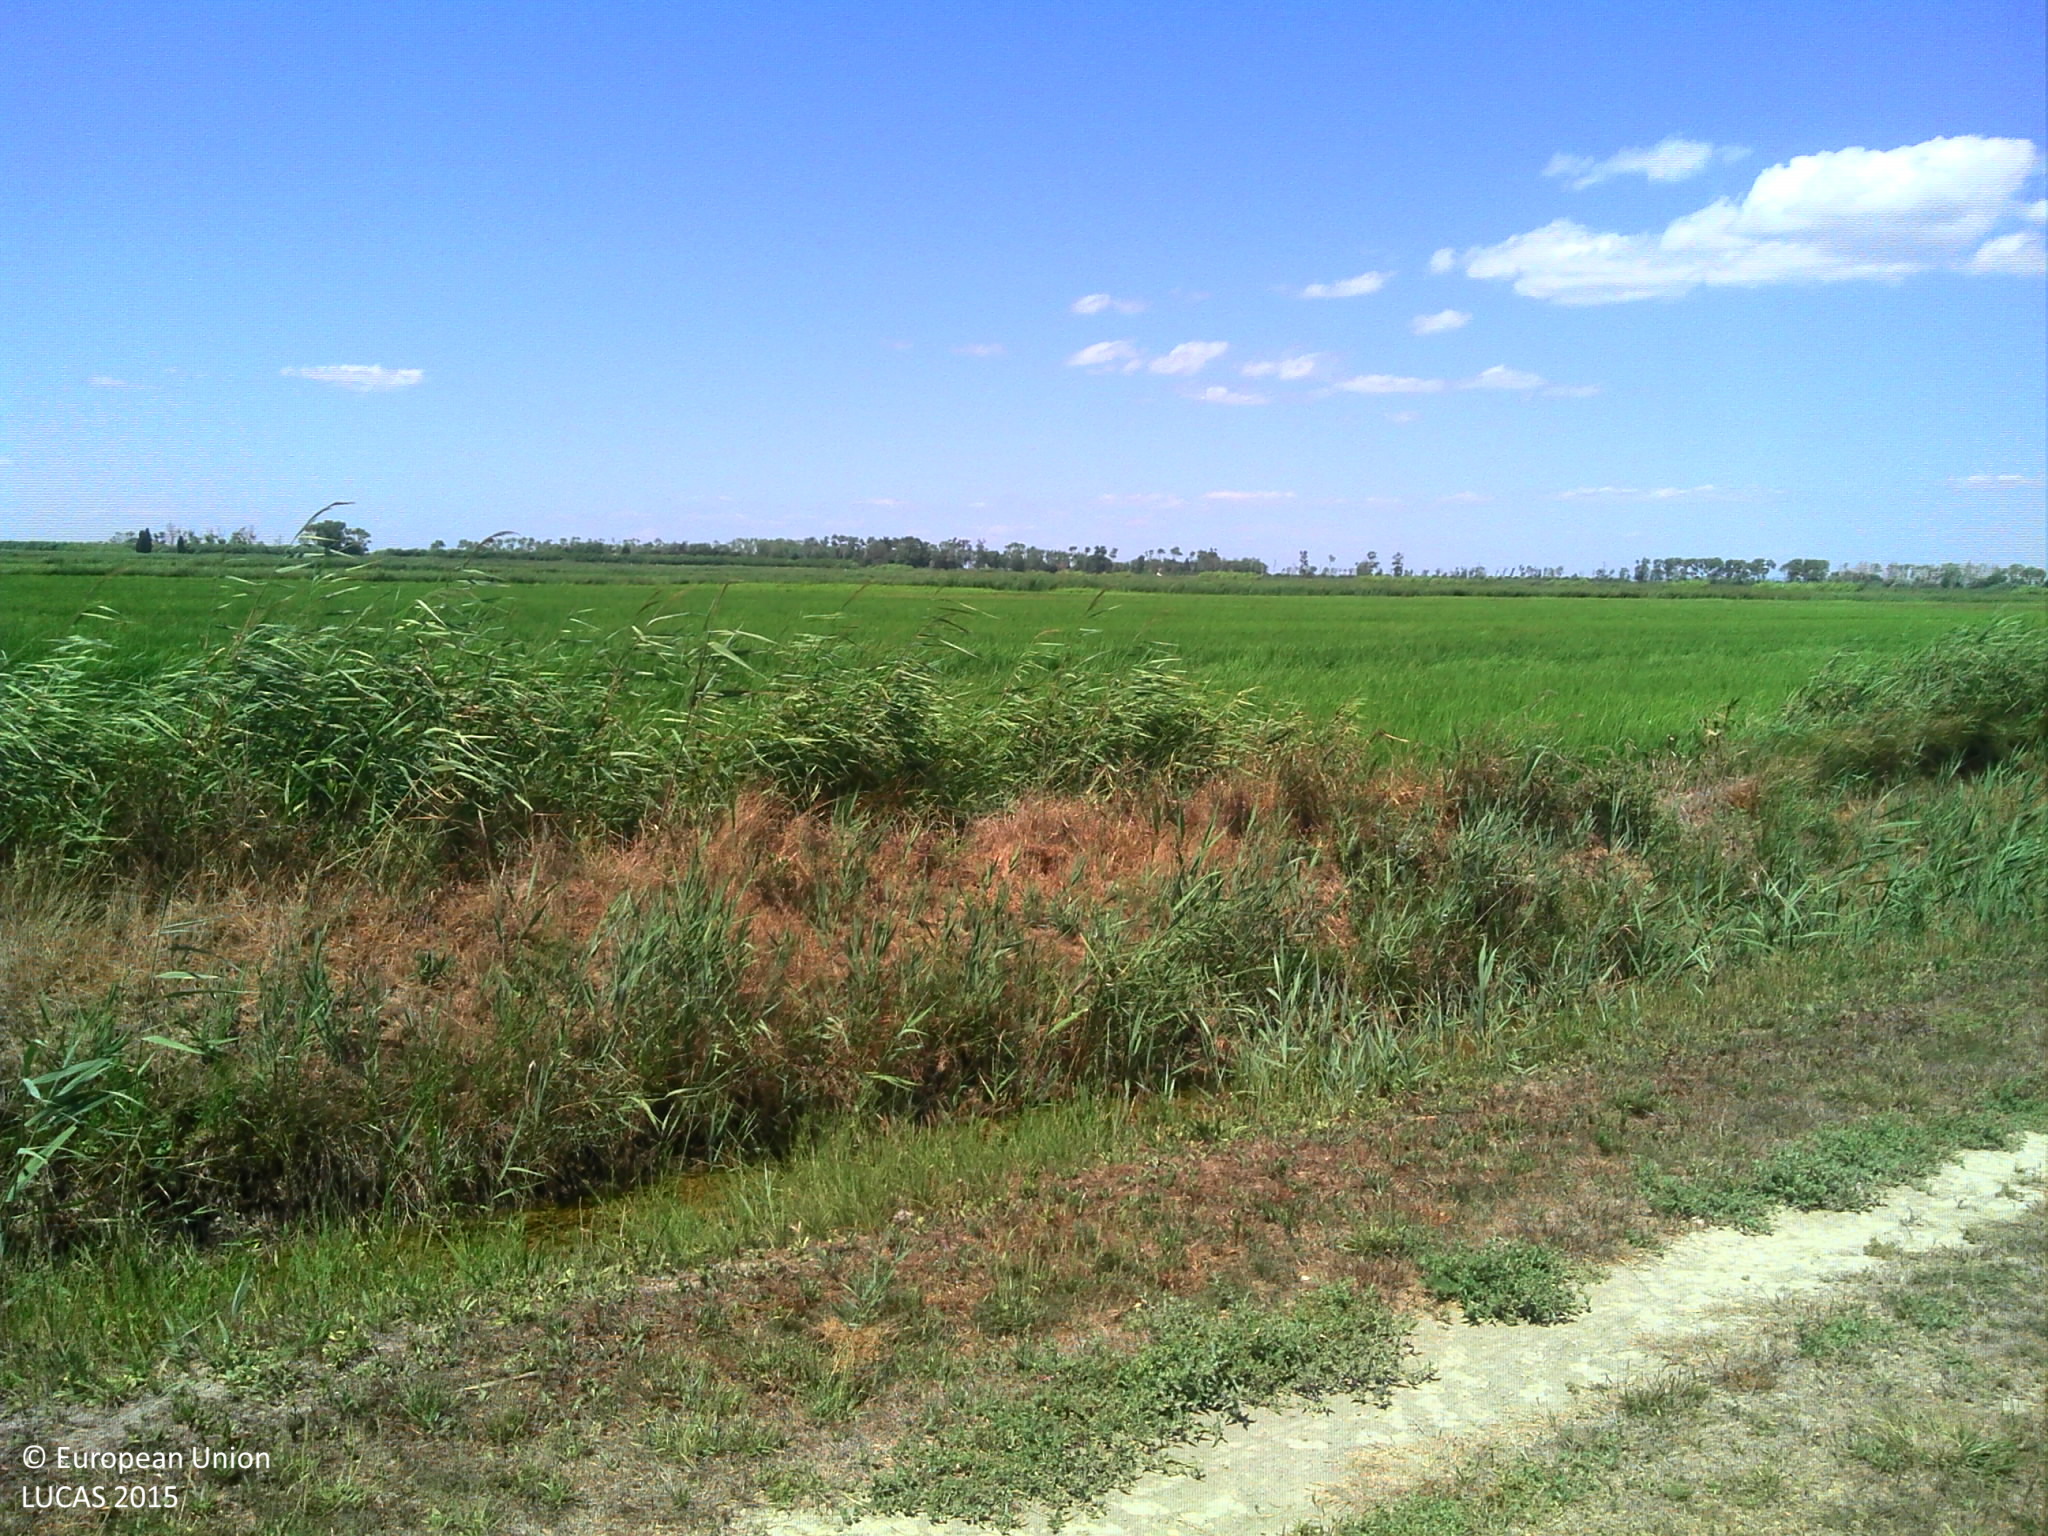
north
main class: Cropland
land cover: Rice
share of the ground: > 75 %
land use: Agriculture (excluding fallow land and kitchen gardens)
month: July
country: FR
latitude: 43.4203
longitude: 4.7116
